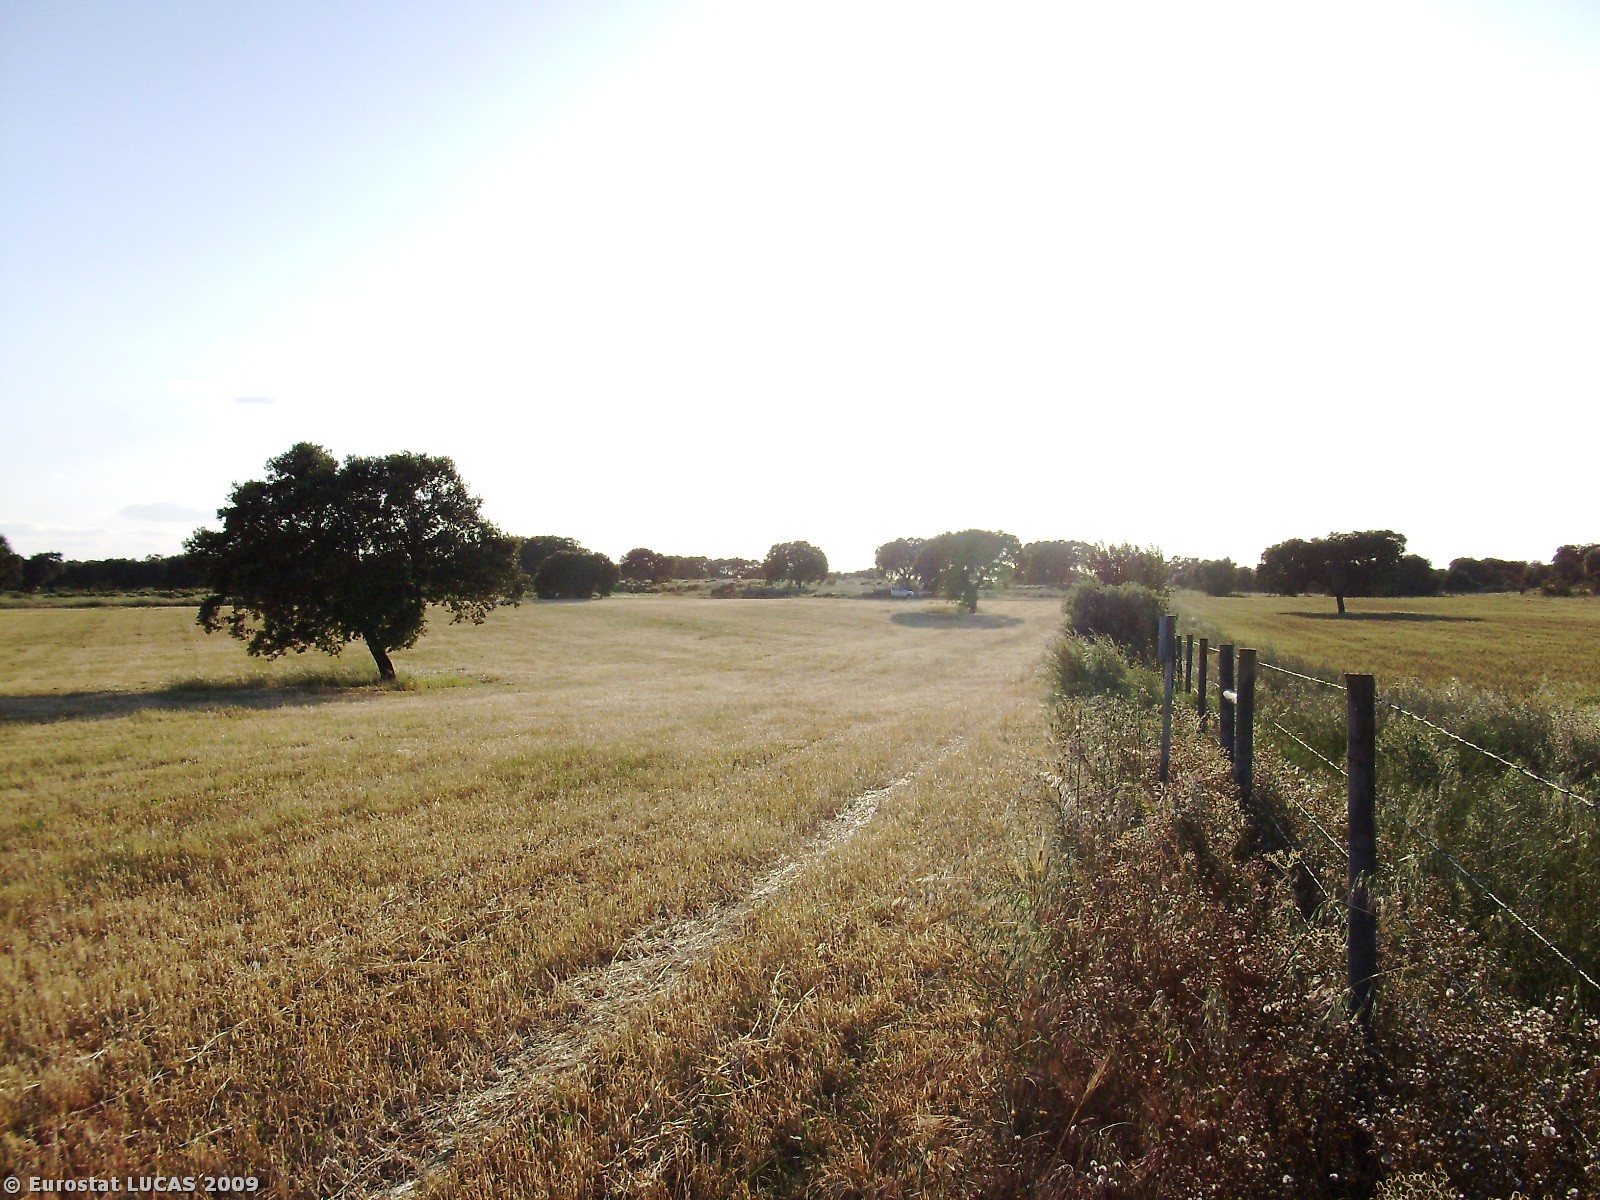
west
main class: Cropland
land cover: Durum wheat
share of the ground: > 75 %
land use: Agriculture (excluding fallow land and kitchen gardens)
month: May
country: PT
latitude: 39.0360
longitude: -7.8730
